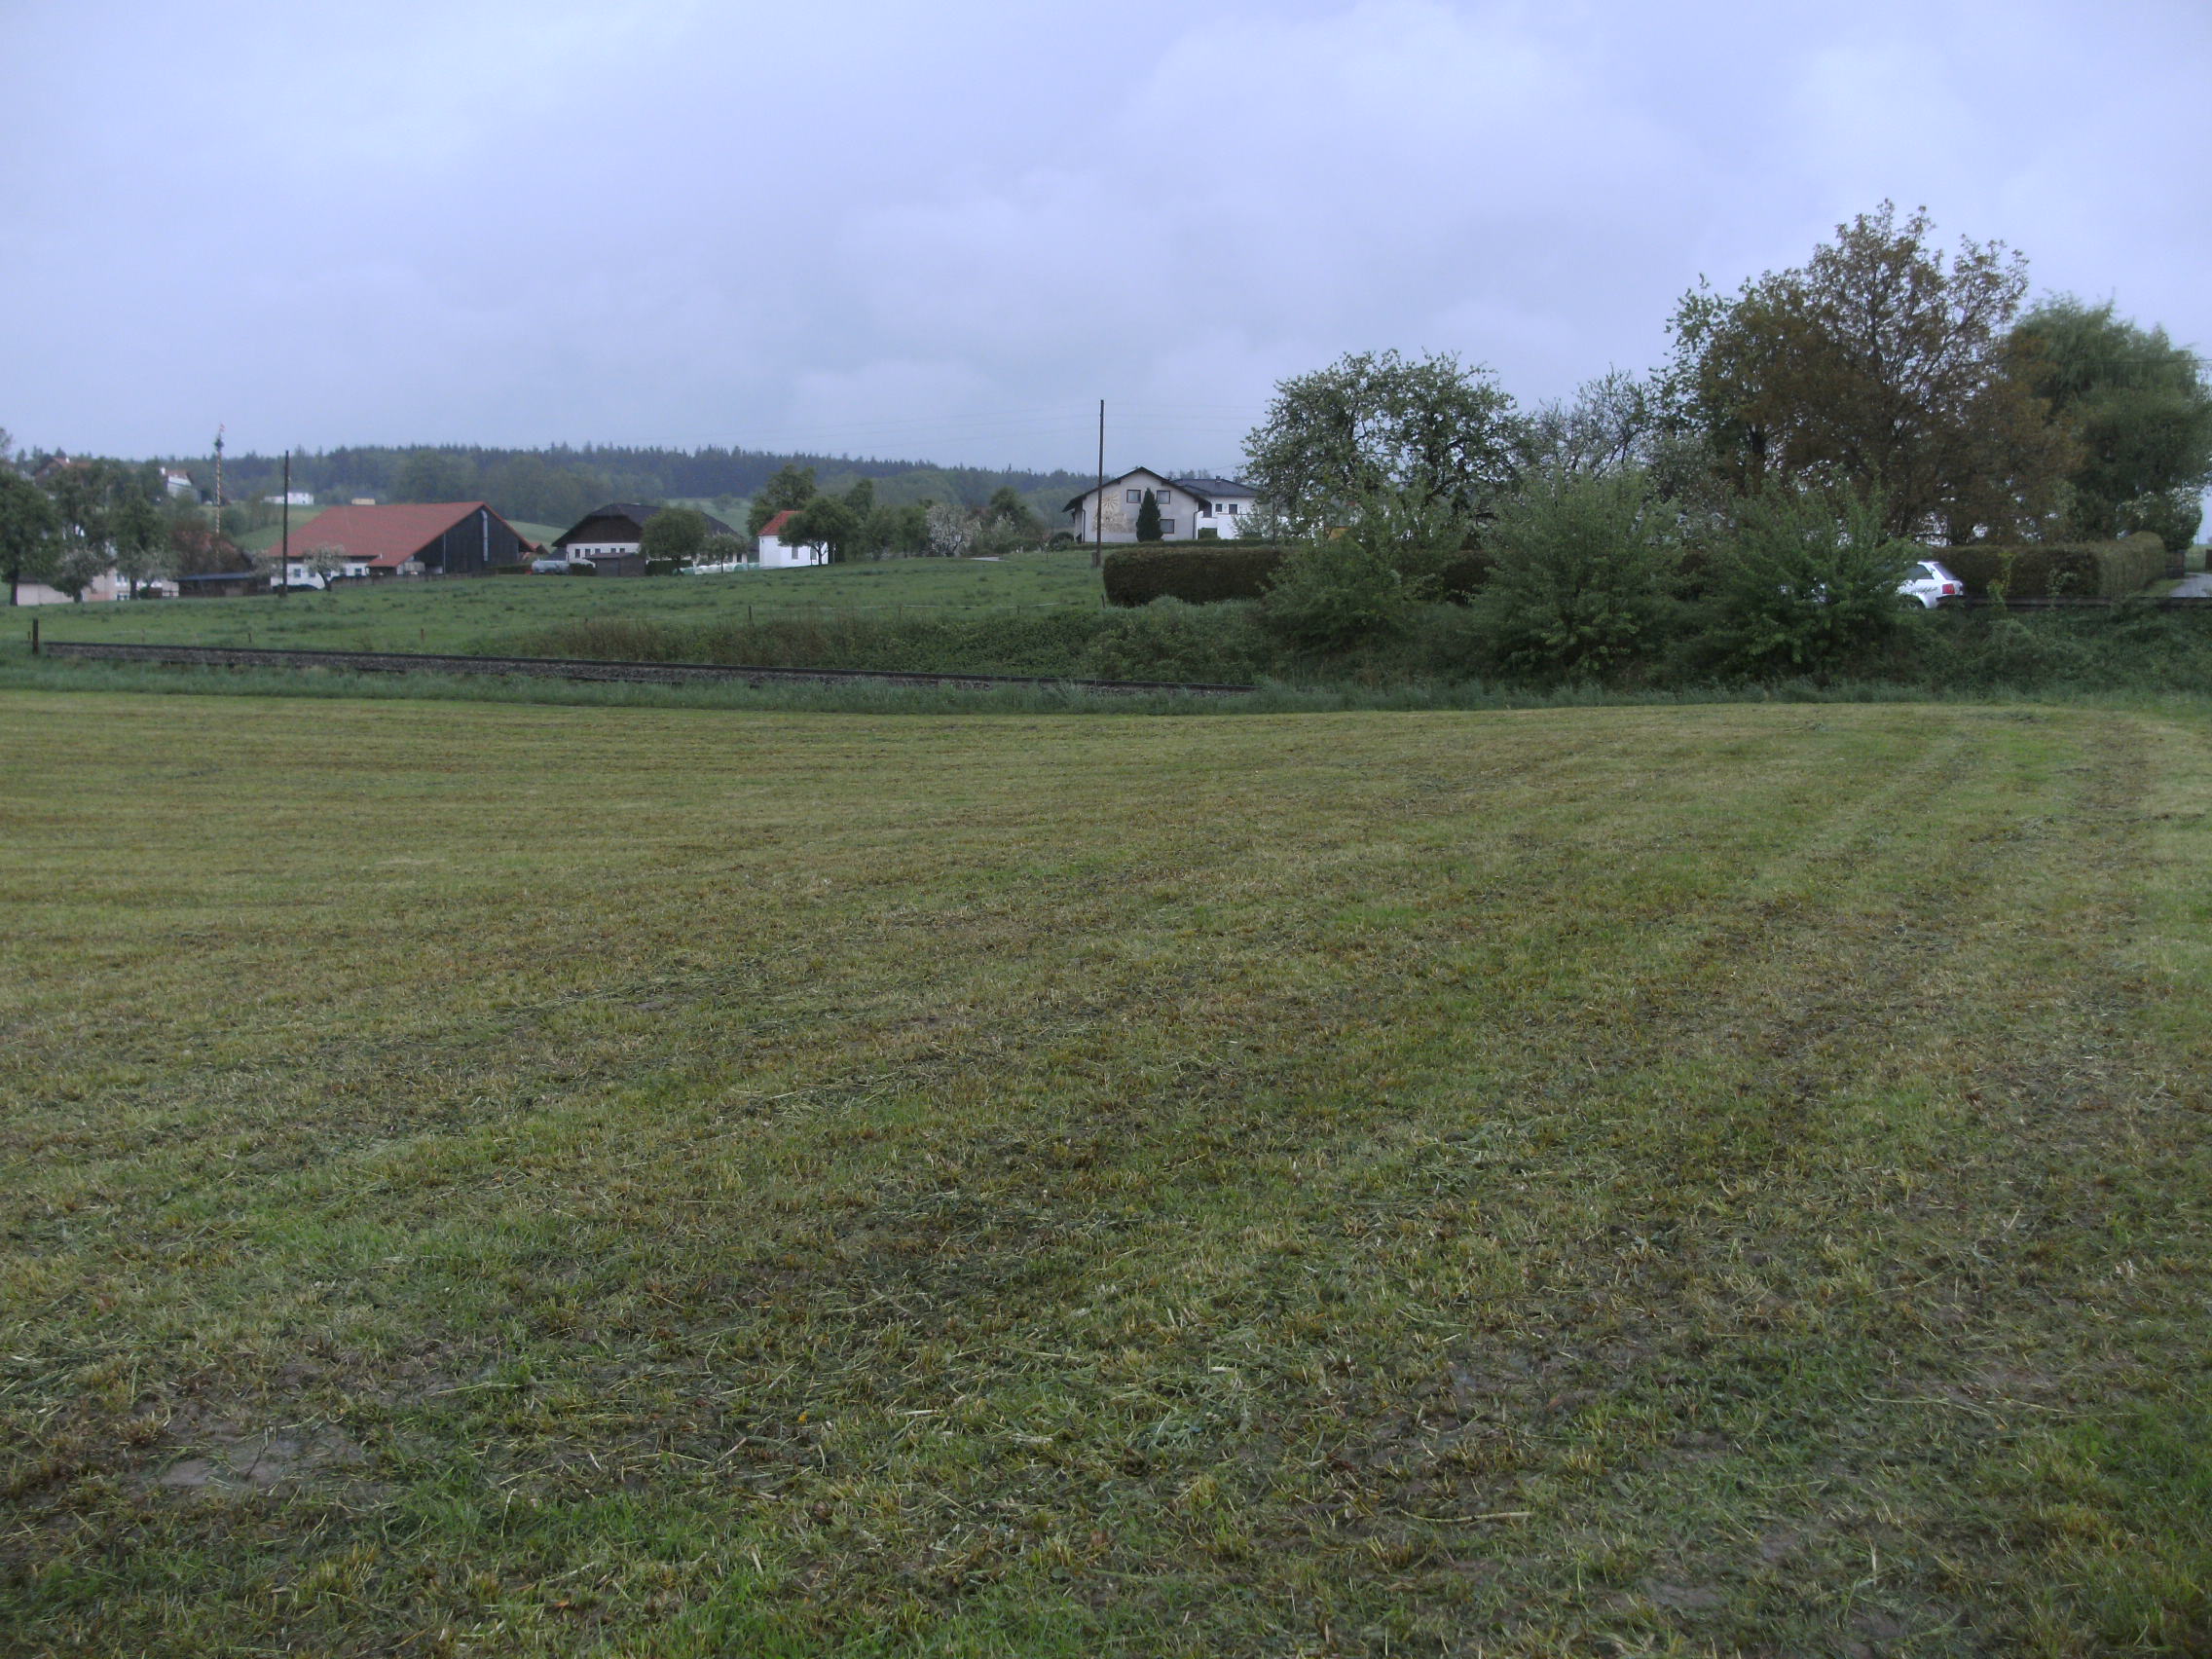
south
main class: Grassland
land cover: Grassland without tree/shrub cover
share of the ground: > 75 %
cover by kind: herbaceous plants 100 %
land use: Agriculture (excluding fallow land and kitchen gardens)
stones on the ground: < 10 %
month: May
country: AT
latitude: 48.2259
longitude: 13.3780
